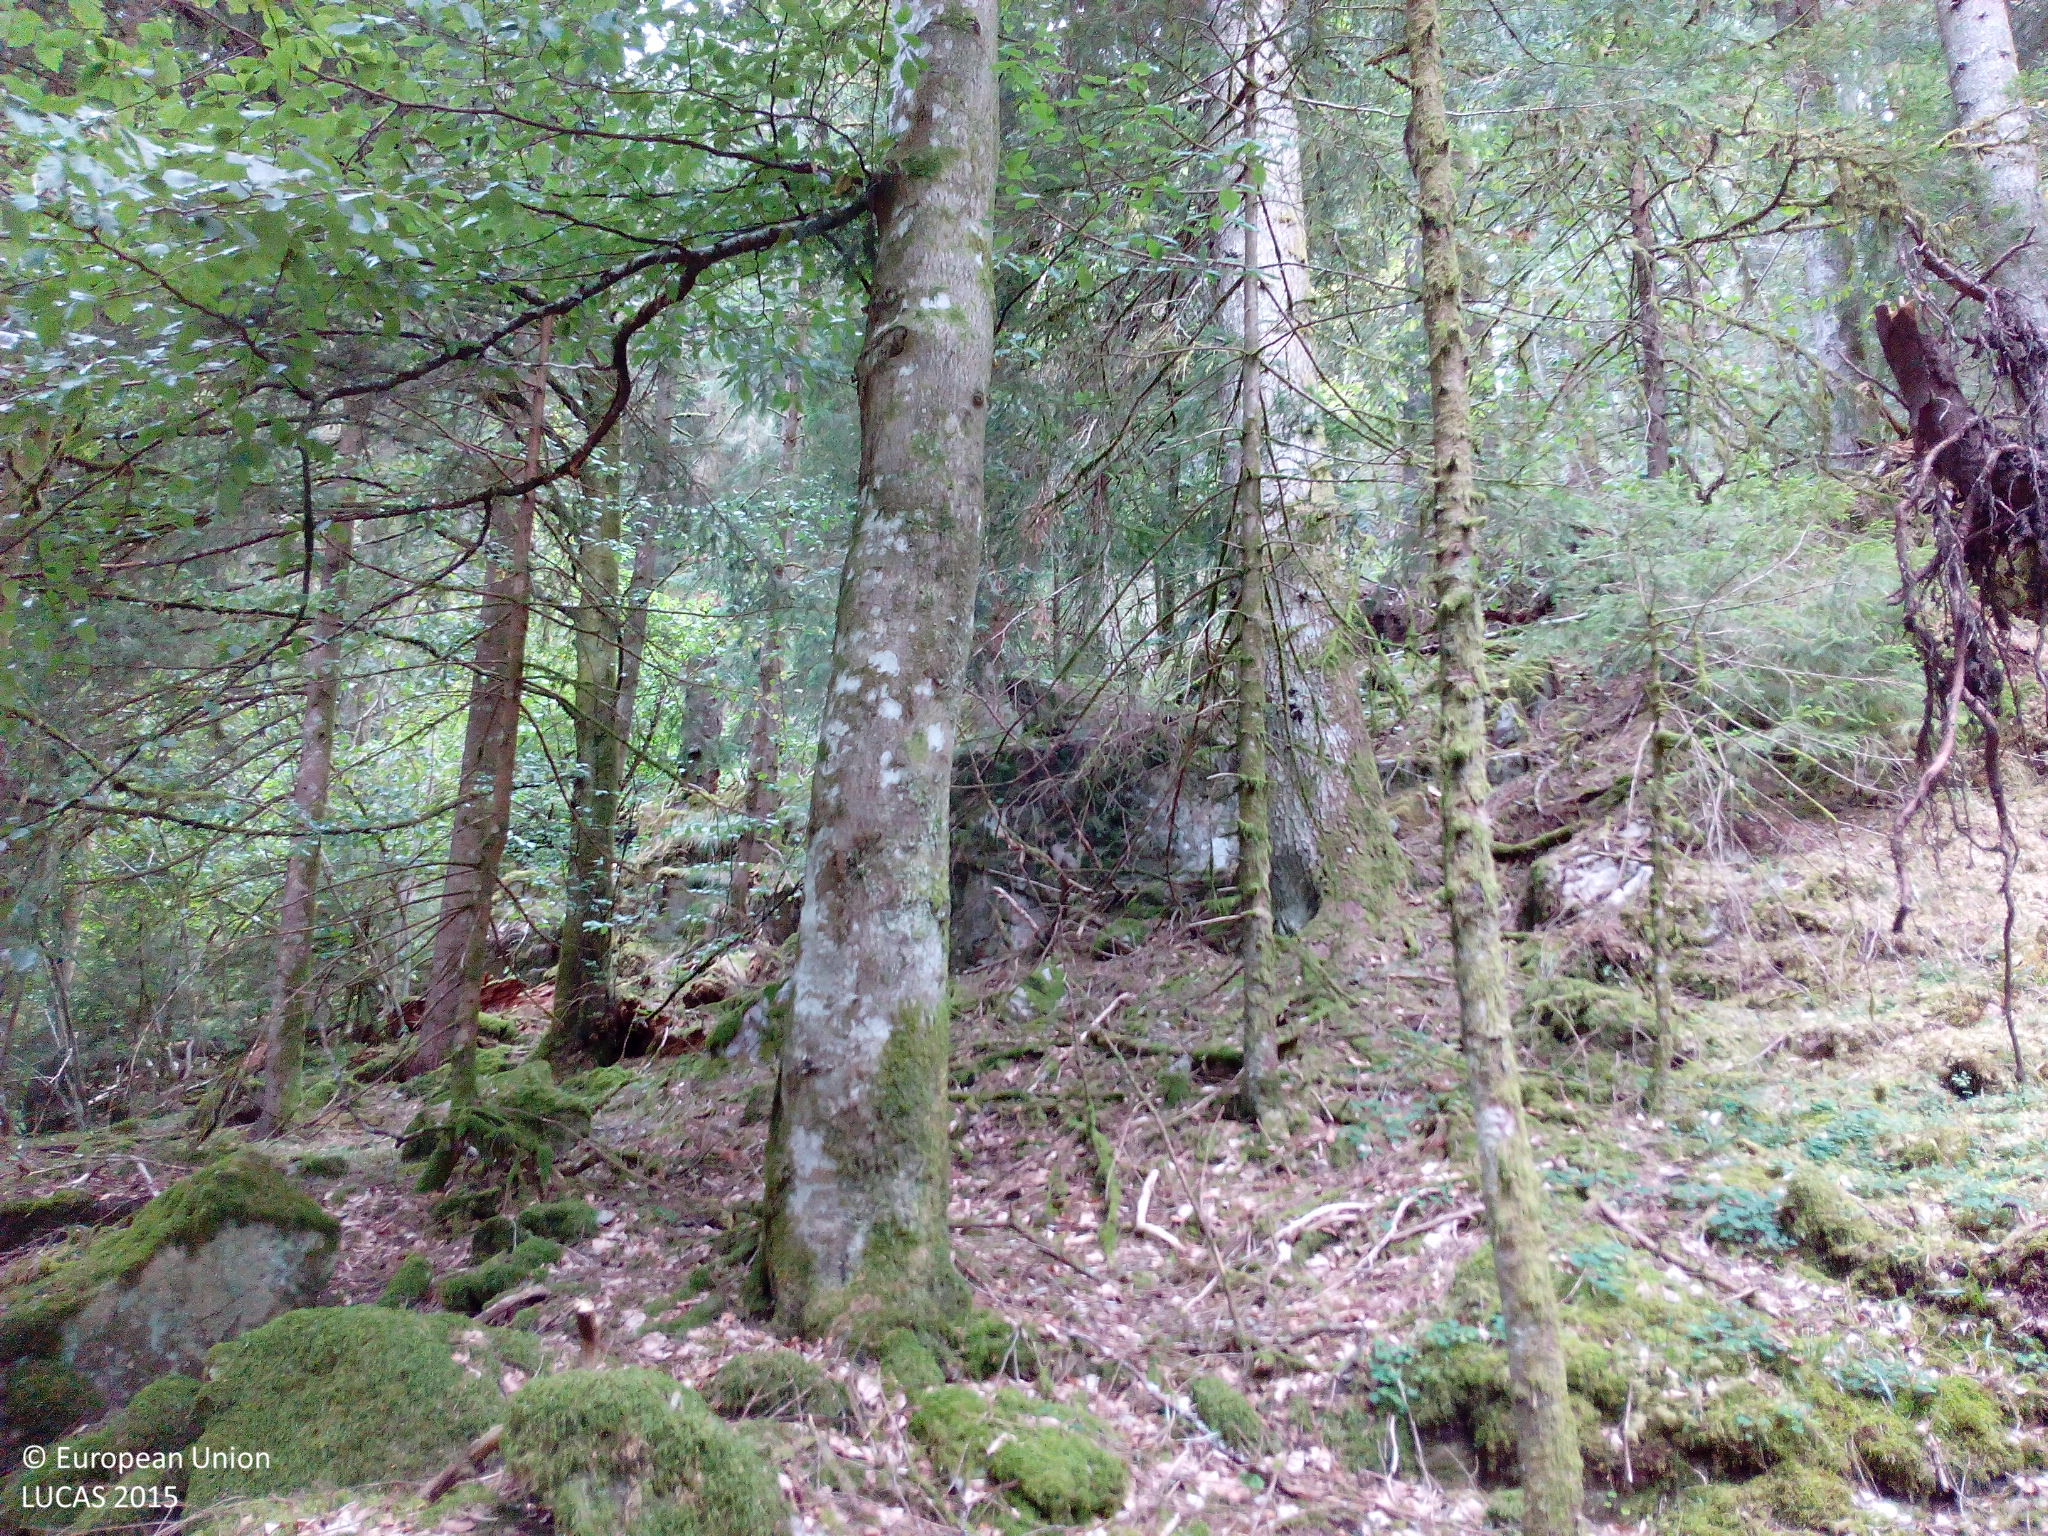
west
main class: Woodland
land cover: Spruce dominated mixed woodland
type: mesophytic deciduous forest
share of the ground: > 75 %
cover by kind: coniferous forest trees 50 %, broadleaved forest trees 25 %, lichens and mosses 10 %, shrubs 5 %, herbaceous plants 5 %, unconsolidated bare surface 5 %
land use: Forestry
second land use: Amenities, museums, leisure
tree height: > 5 m
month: August
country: DE
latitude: 47.7408
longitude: 8.2009
